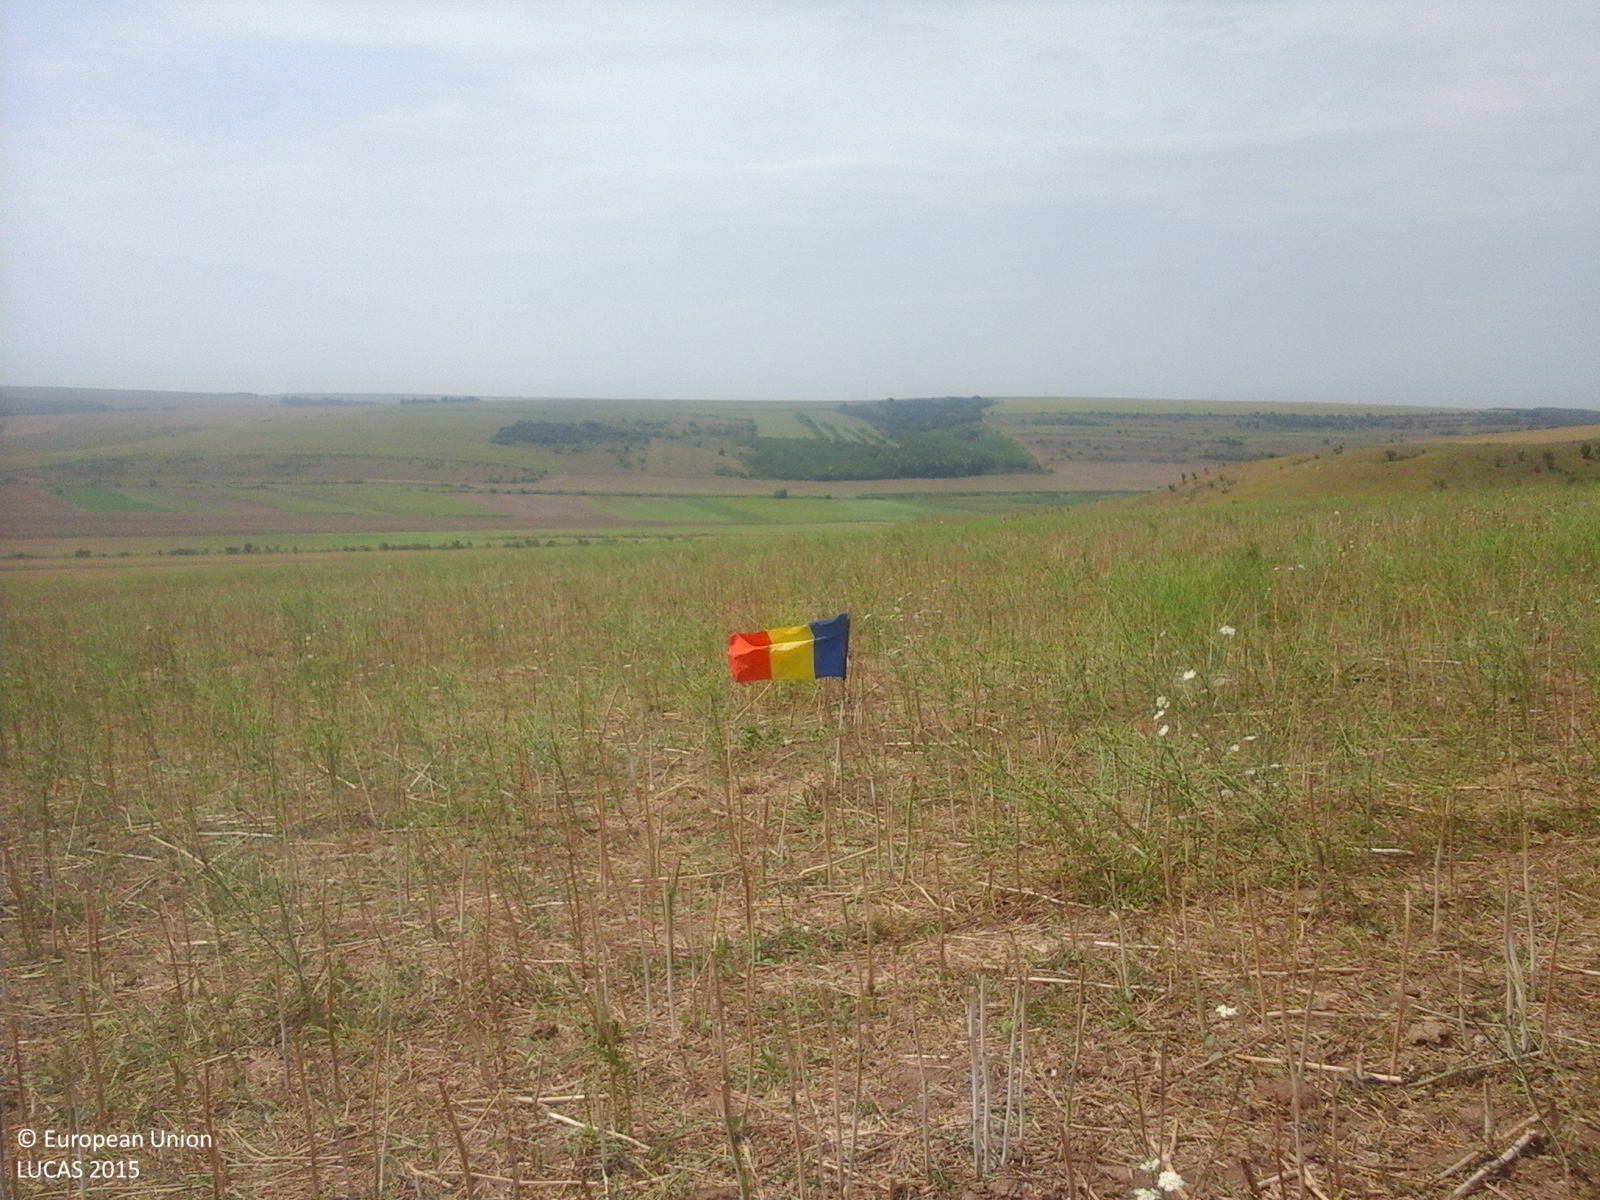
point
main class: Cropland
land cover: Rape and turnip rape
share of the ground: 25 - 50 %
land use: Agriculture (excluding fallow land and kitchen gardens)
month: August
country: RO
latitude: 44.0401
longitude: 27.8561
